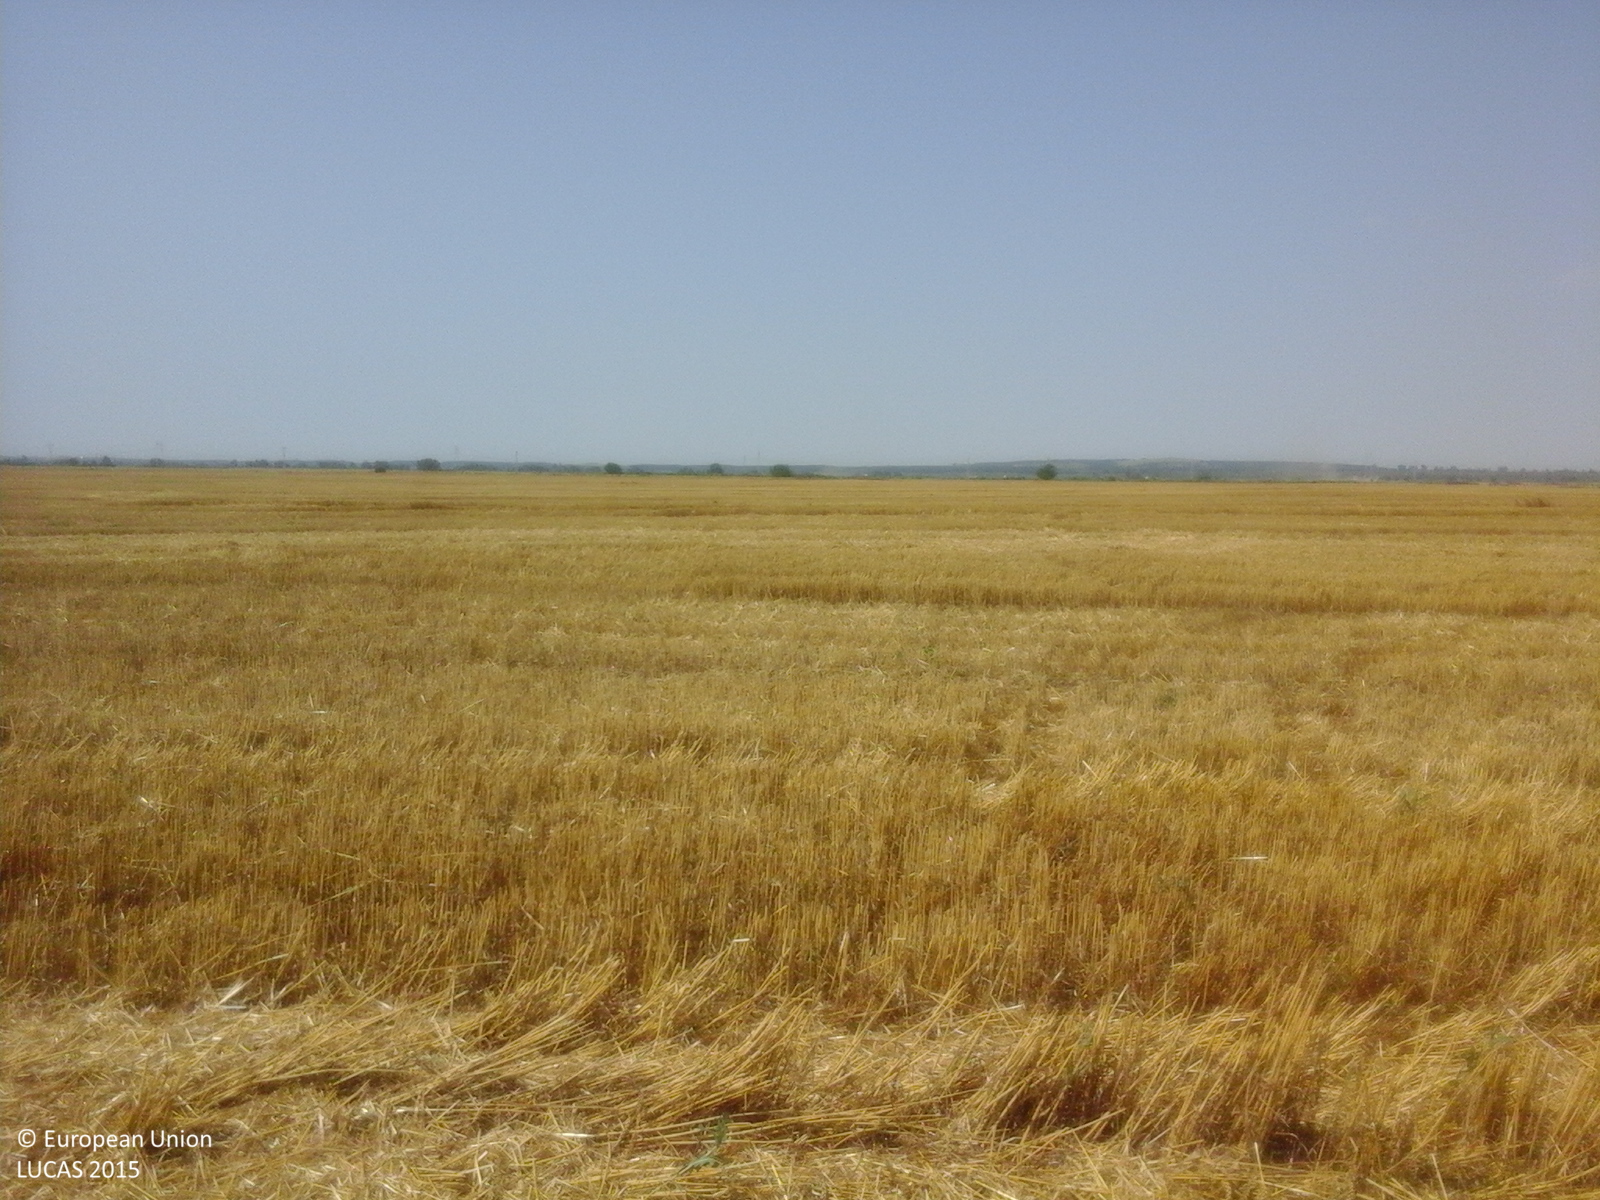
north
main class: Cropland
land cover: Common wheat
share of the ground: 50 - 75 %
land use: Agriculture (excluding fallow land and kitchen gardens)
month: July
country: RO
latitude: 44.6070
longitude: 27.9878
